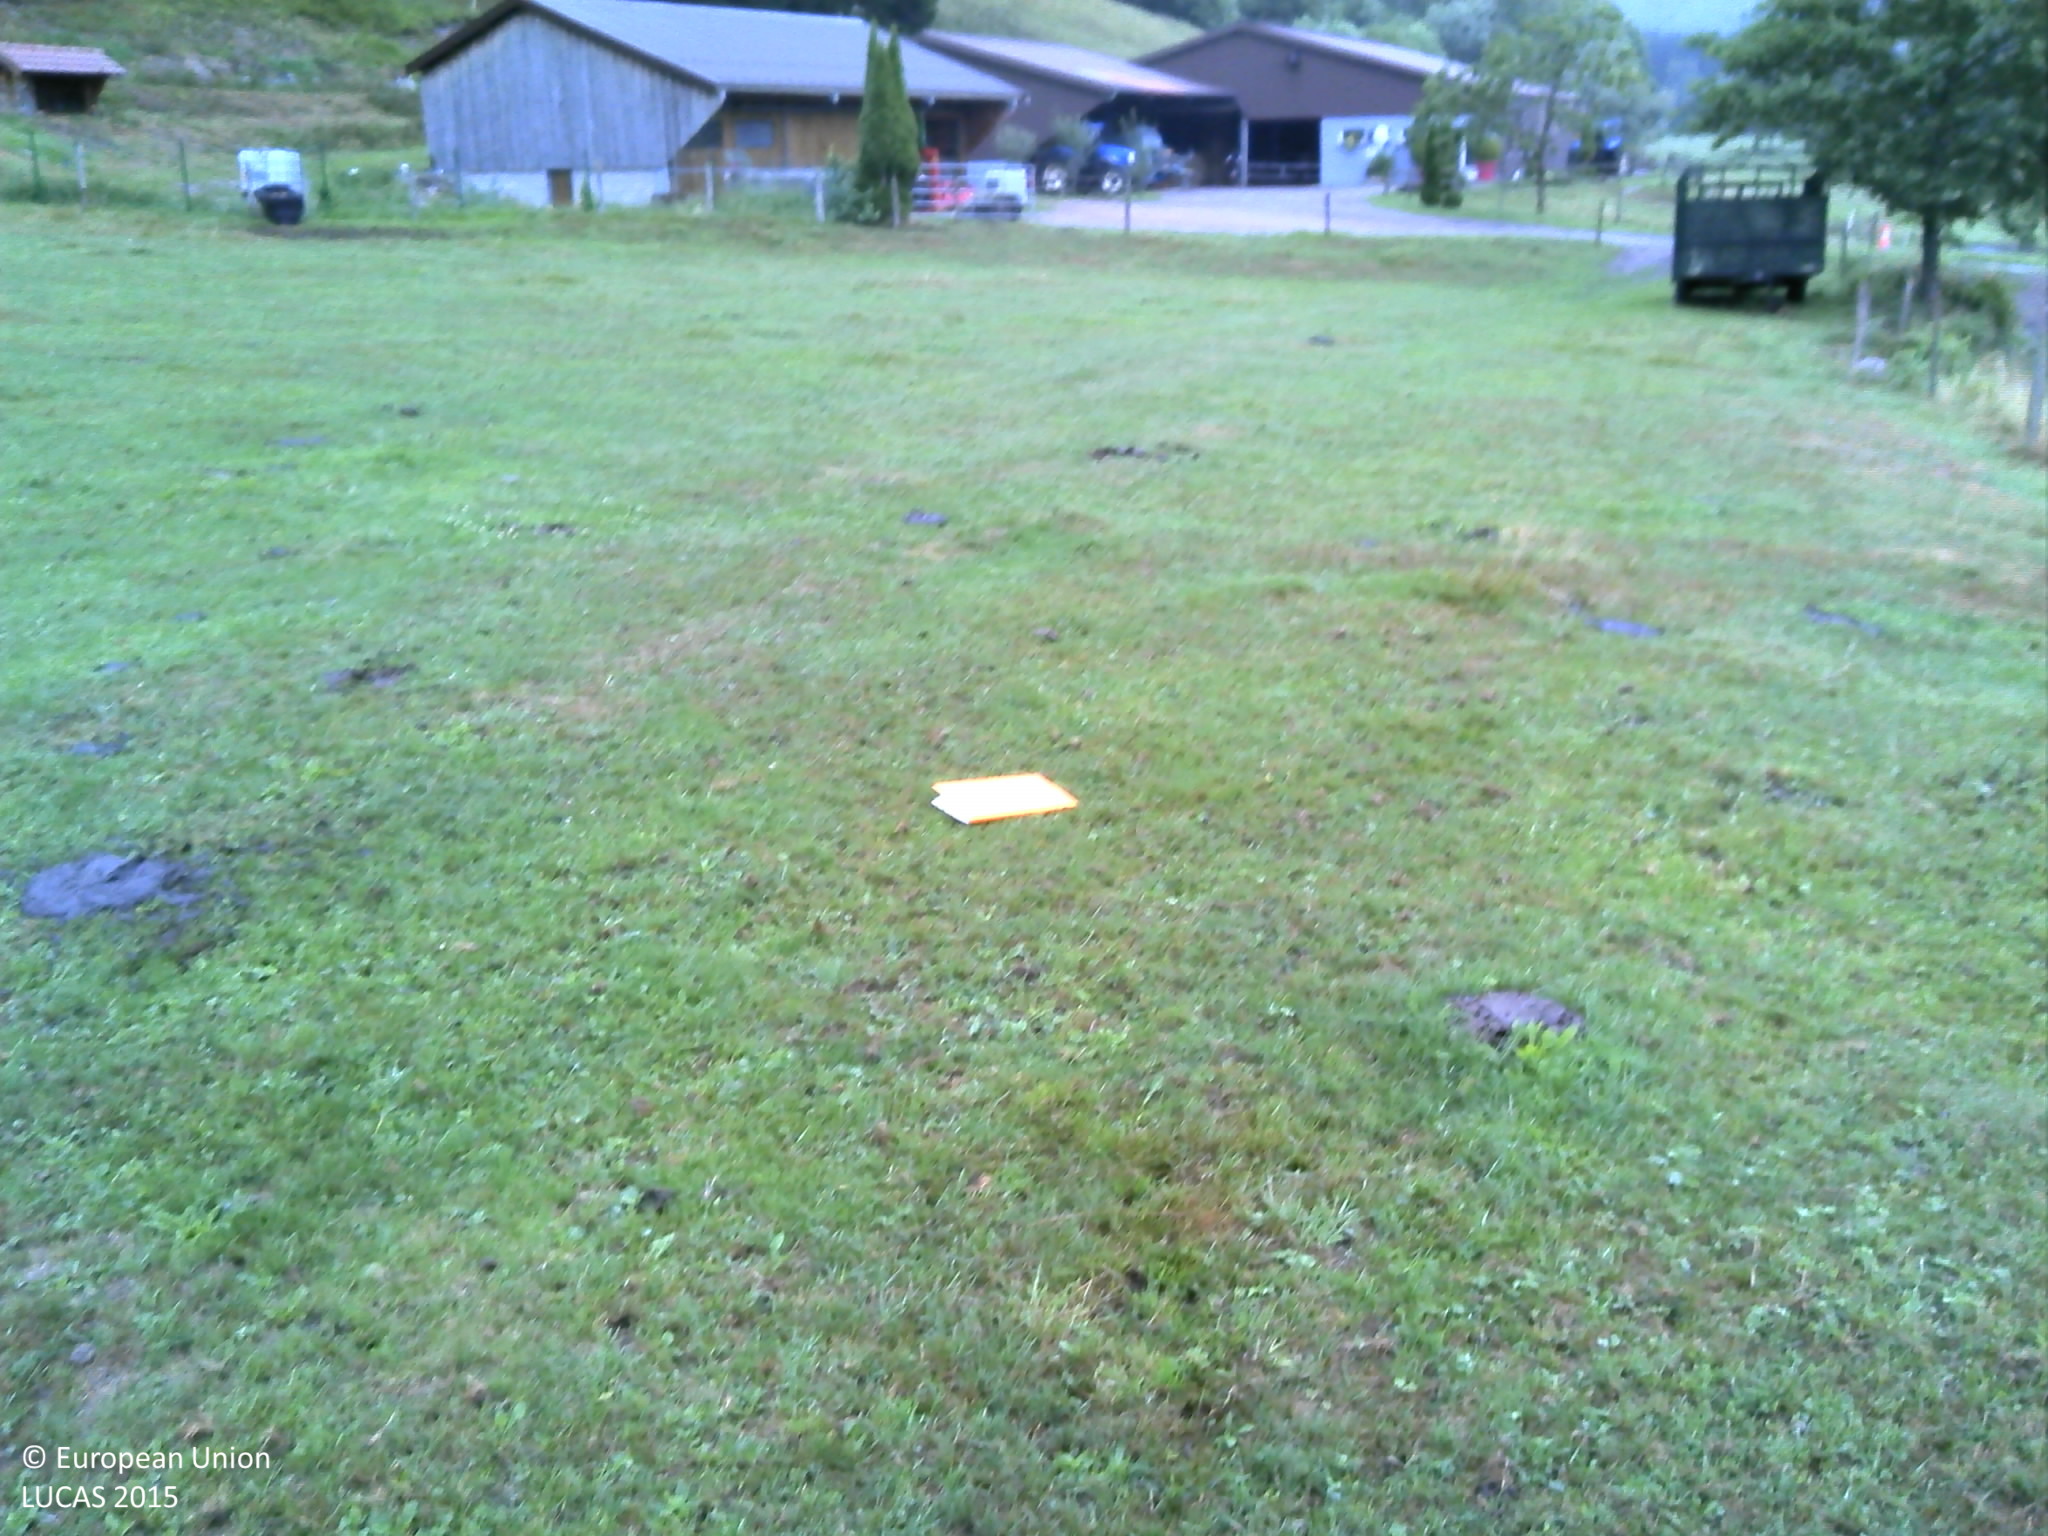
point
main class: Grassland
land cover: Grassland without tree/shrub cover
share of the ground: > 75 %
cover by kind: herbaceous plants 100 %
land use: Agriculture (excluding fallow land and kitchen gardens)
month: August
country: FR
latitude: 47.8907
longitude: 6.8583
